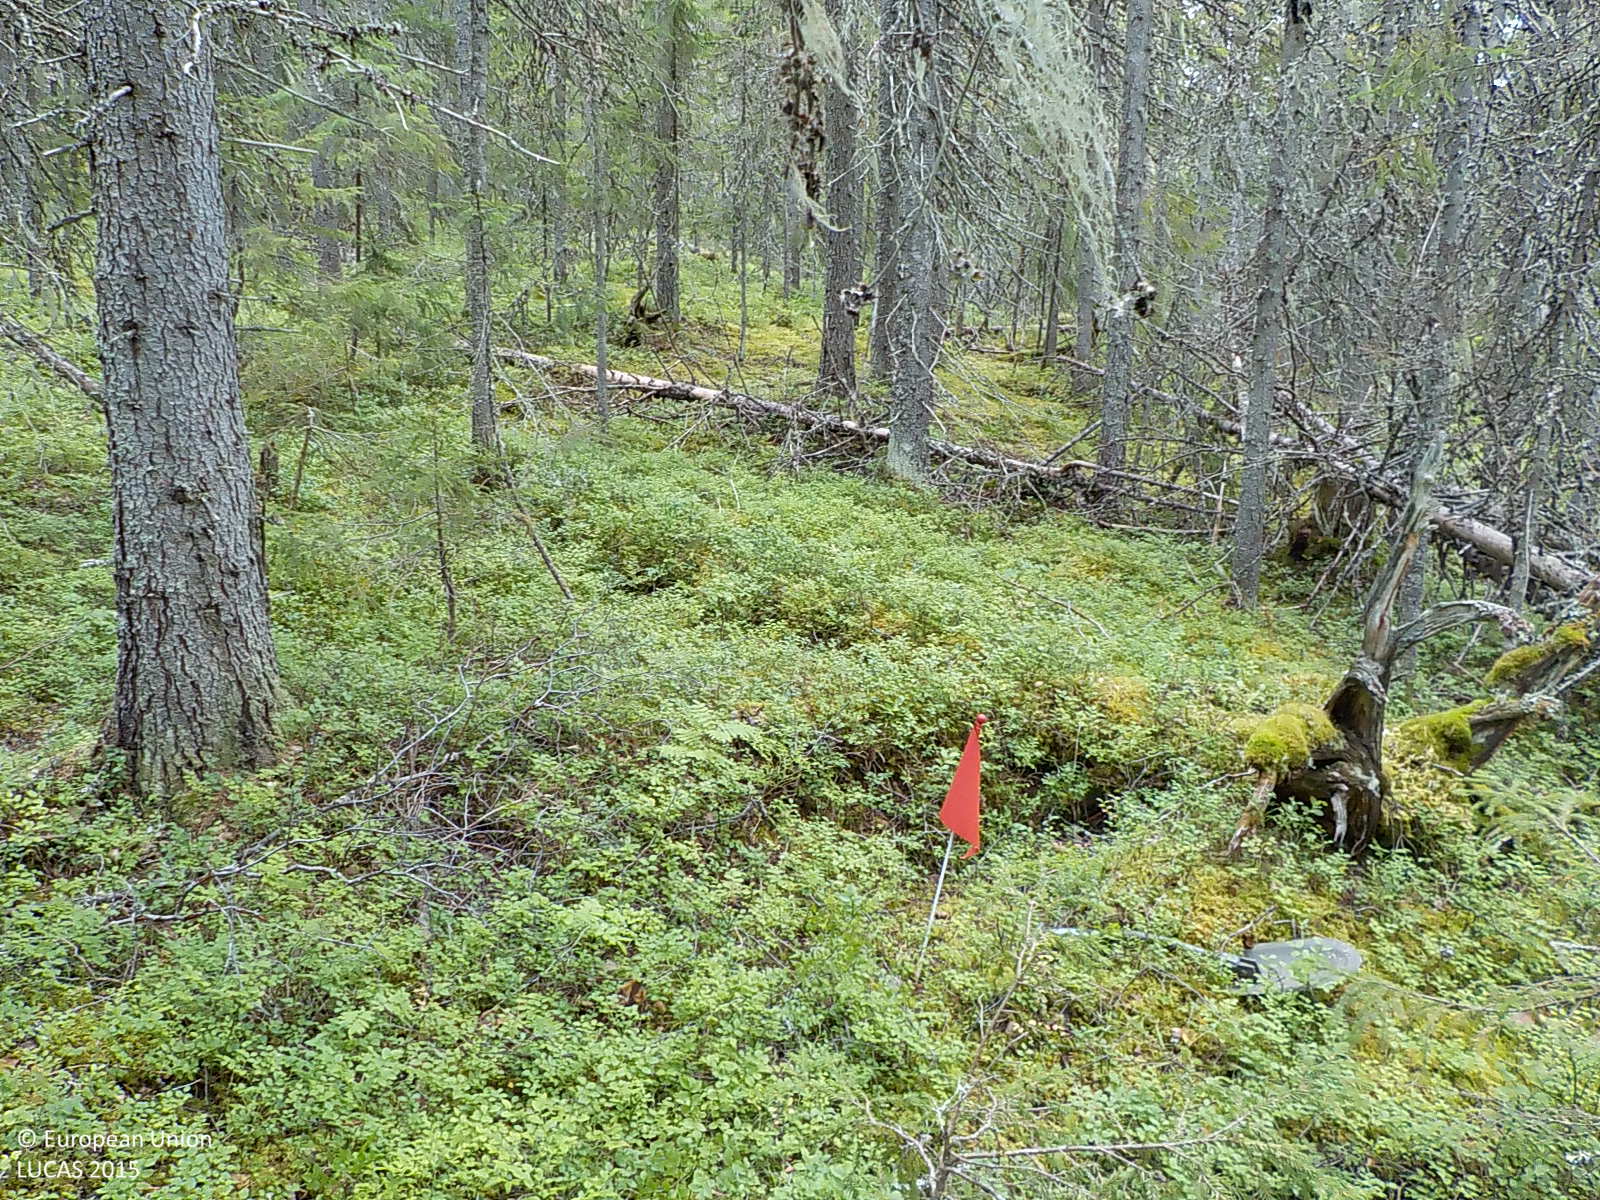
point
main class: Woodland
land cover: Spruce dominated coniferous woodland
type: boreal forest
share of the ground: > 75 %
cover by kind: coniferous forest trees 85 %, shrubs 15 %
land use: Forestry
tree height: > 5 m
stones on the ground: 10 - 25 %
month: September
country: SE
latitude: 63.2781
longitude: 17.8496
